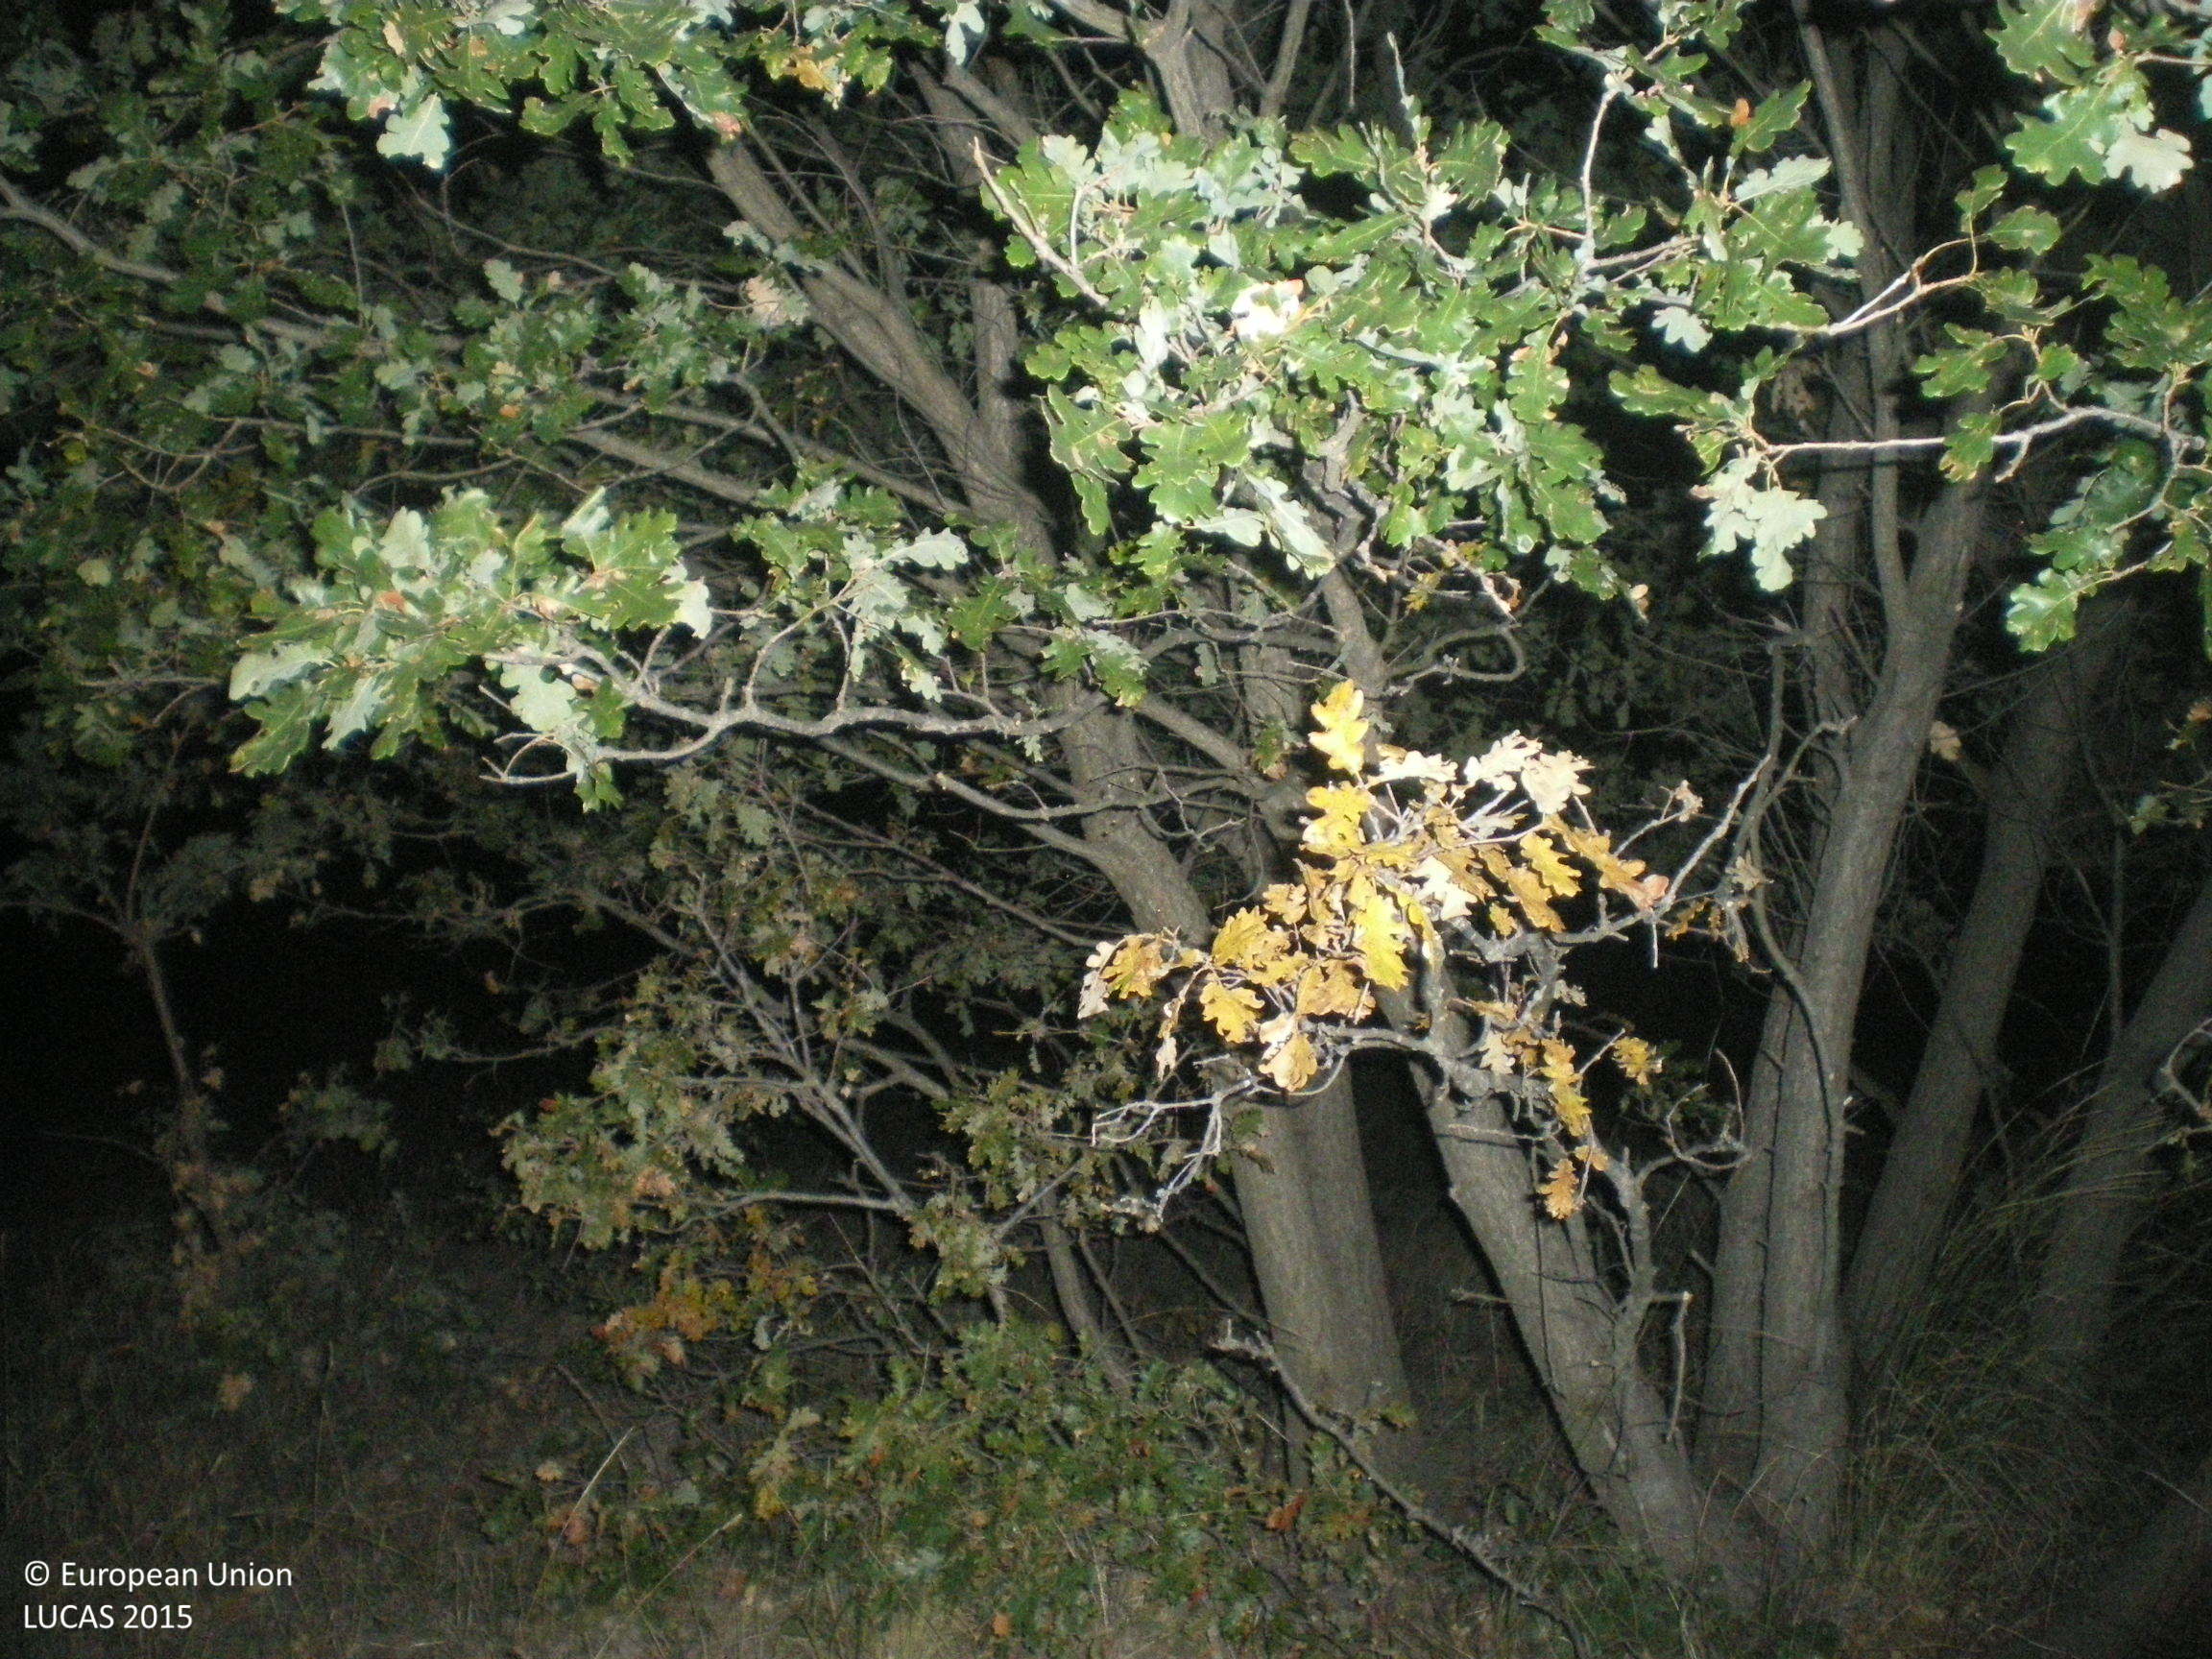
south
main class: Grassland
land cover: Grassland with sparse tree/shrub cover
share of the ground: > 75 %
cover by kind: herbaceous plants 85 %, shrubs 10 %, broadleaved forest trees 5 %
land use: Semi-natural and natural areas not in use
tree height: > 5 m
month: October
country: BG
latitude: 41.8943
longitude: 26.0687
